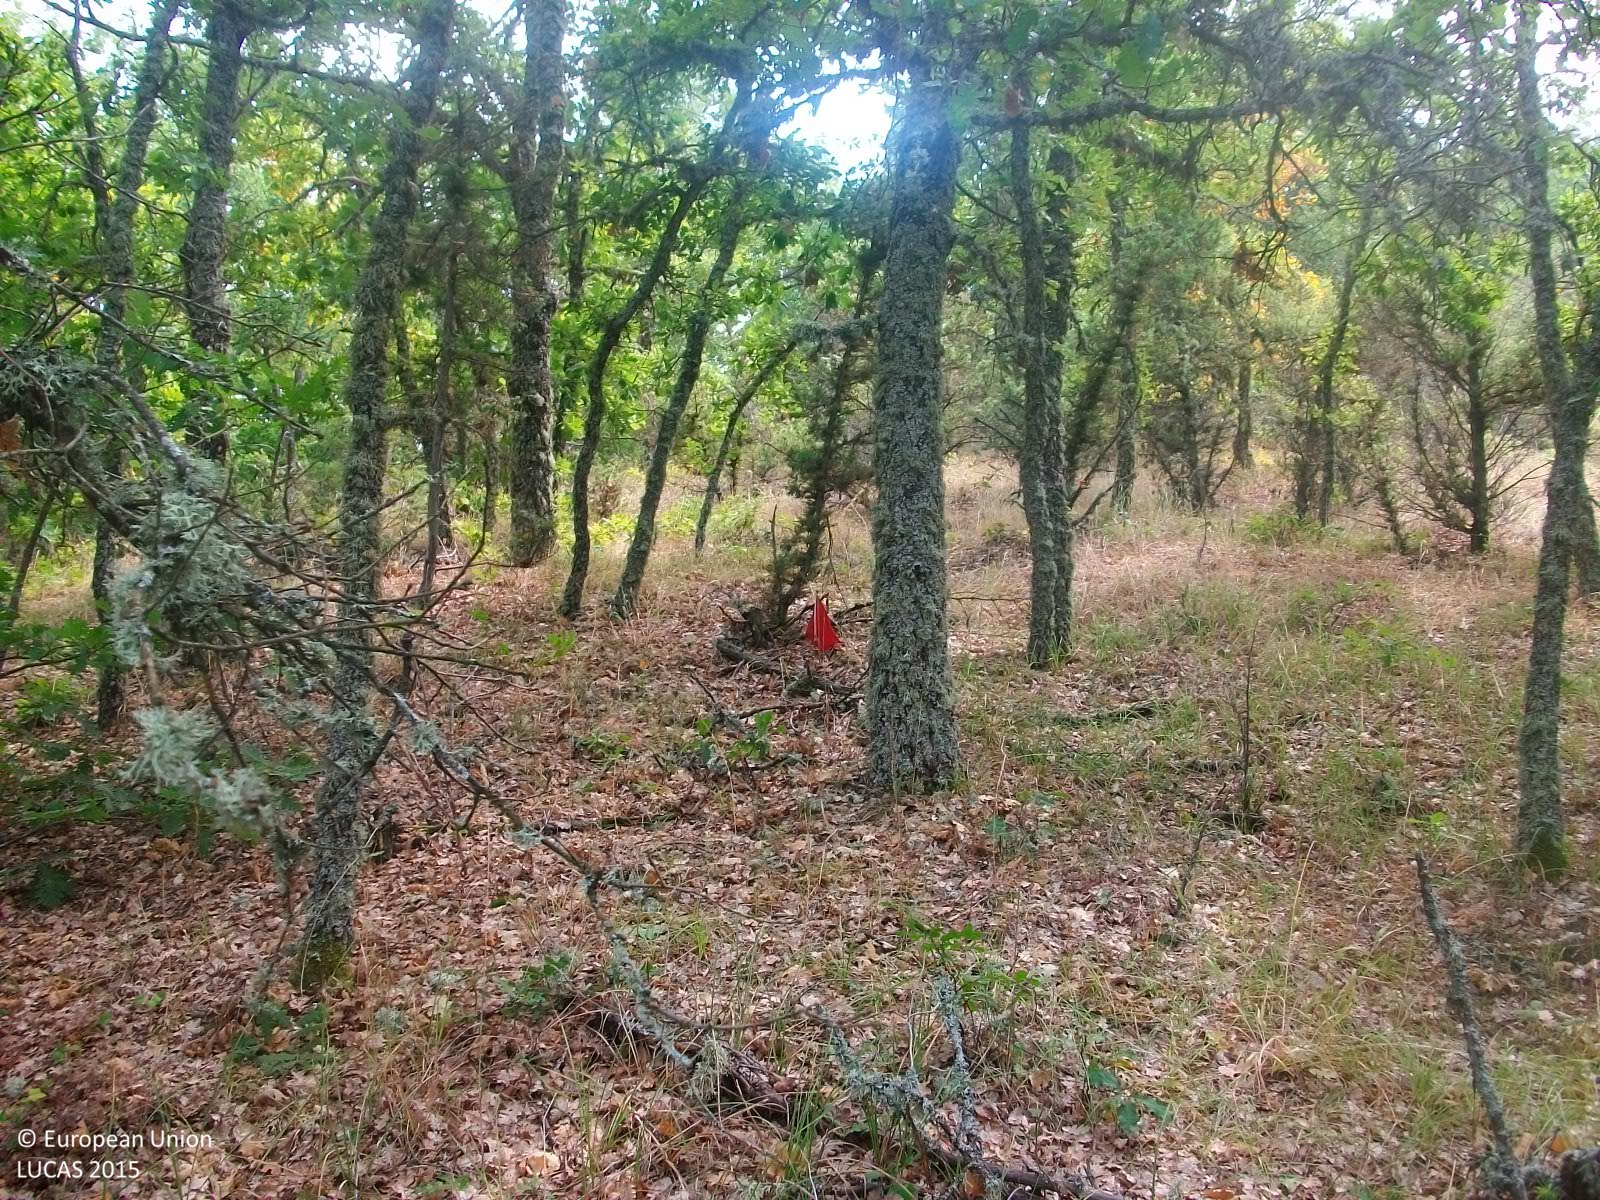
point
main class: Woodland
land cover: Broadleaved woodland
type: thermophilous deciduous forest
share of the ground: > 75 %
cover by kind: broadleaved forest trees 90 %, shrubs 5 %, herbaceous plants 5 %
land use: Forestry
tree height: > 5 m
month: August
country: GR
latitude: 41.3237
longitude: 26.1859
